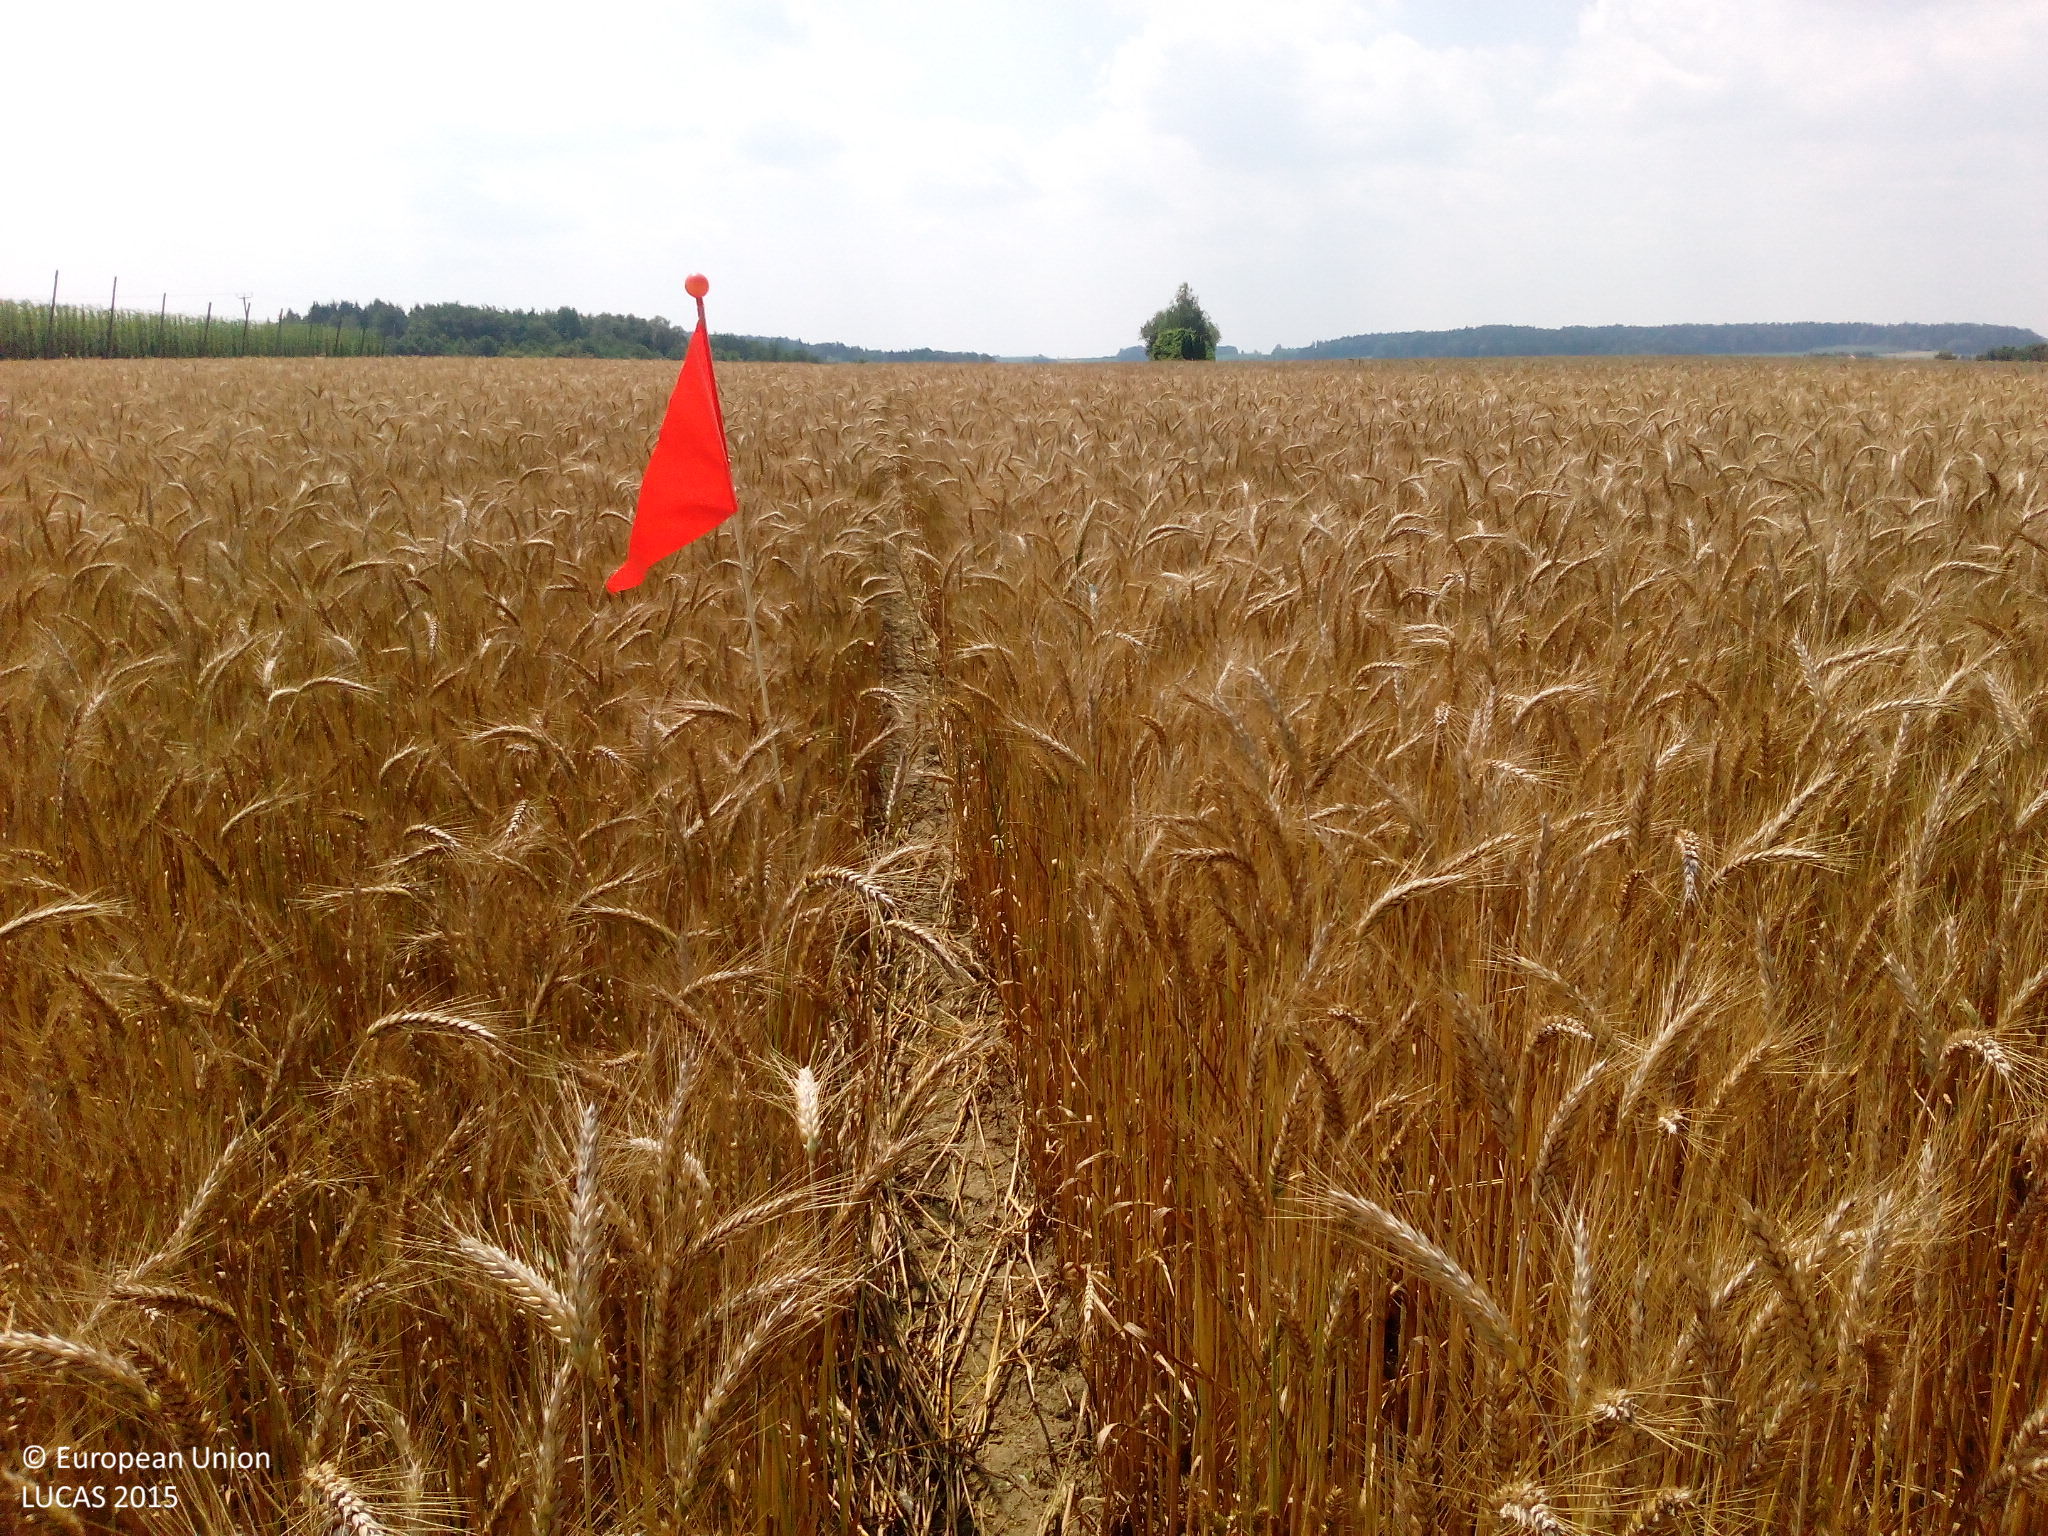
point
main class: Cropland
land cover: Rye
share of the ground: > 75 %
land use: Agriculture (excluding fallow land and kitchen gardens)
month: July
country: DE
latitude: 48.8008
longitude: 11.9190
